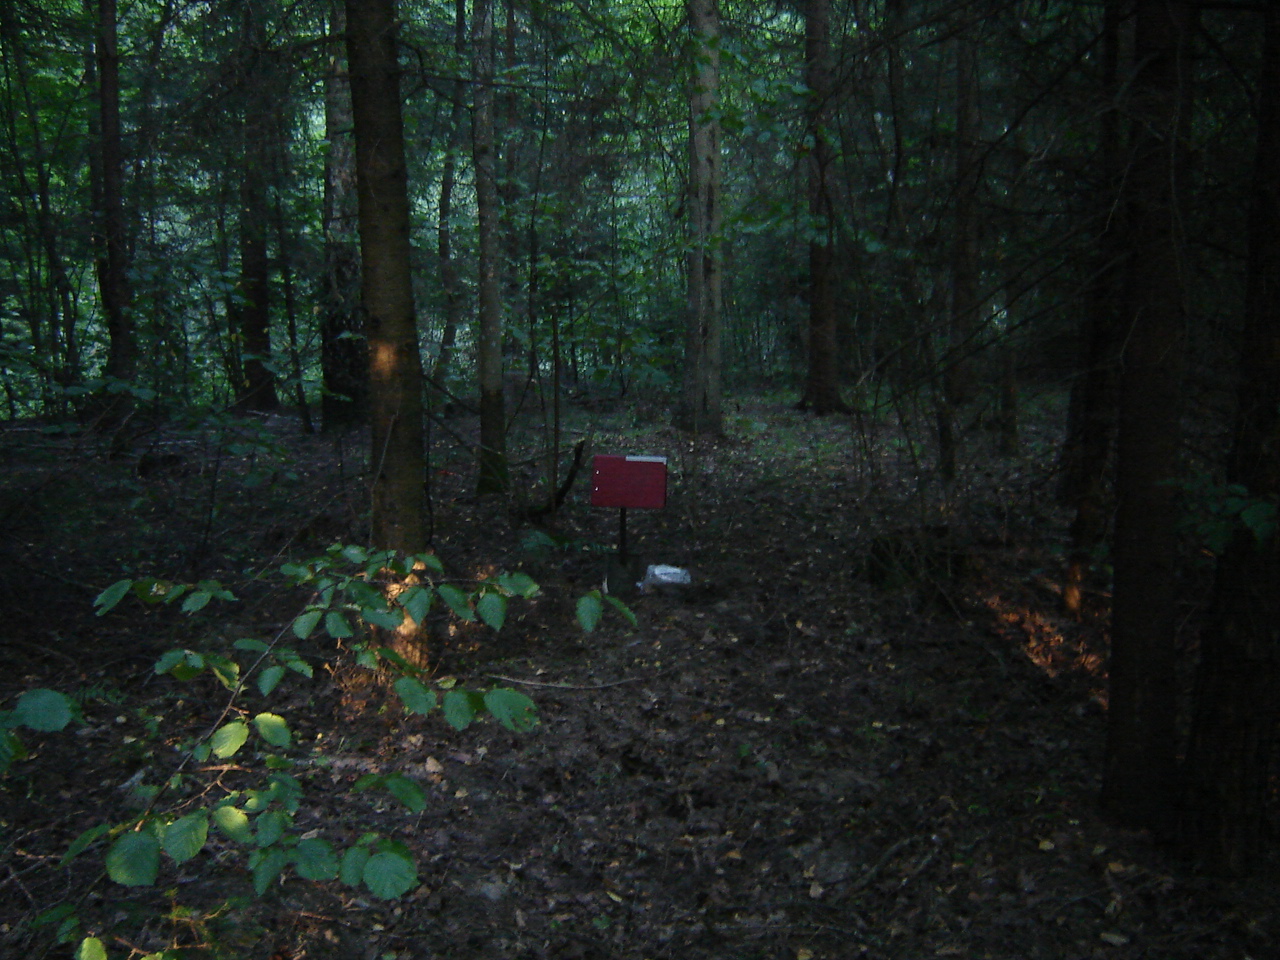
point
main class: Woodland
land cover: Spruce dominated mixed woodland
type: hemiboreal forest and nemoral coniferous forest and mixed broadleaved-coniferous forest
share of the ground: > 75 %
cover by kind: coniferous forest trees 65 %, broadleaved forest trees 30 %, unconsolidated bare surface 5 %
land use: Forestry
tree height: > 5 m
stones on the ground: < 10 %
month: August
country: LT
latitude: 54.8038
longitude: 25.0022
